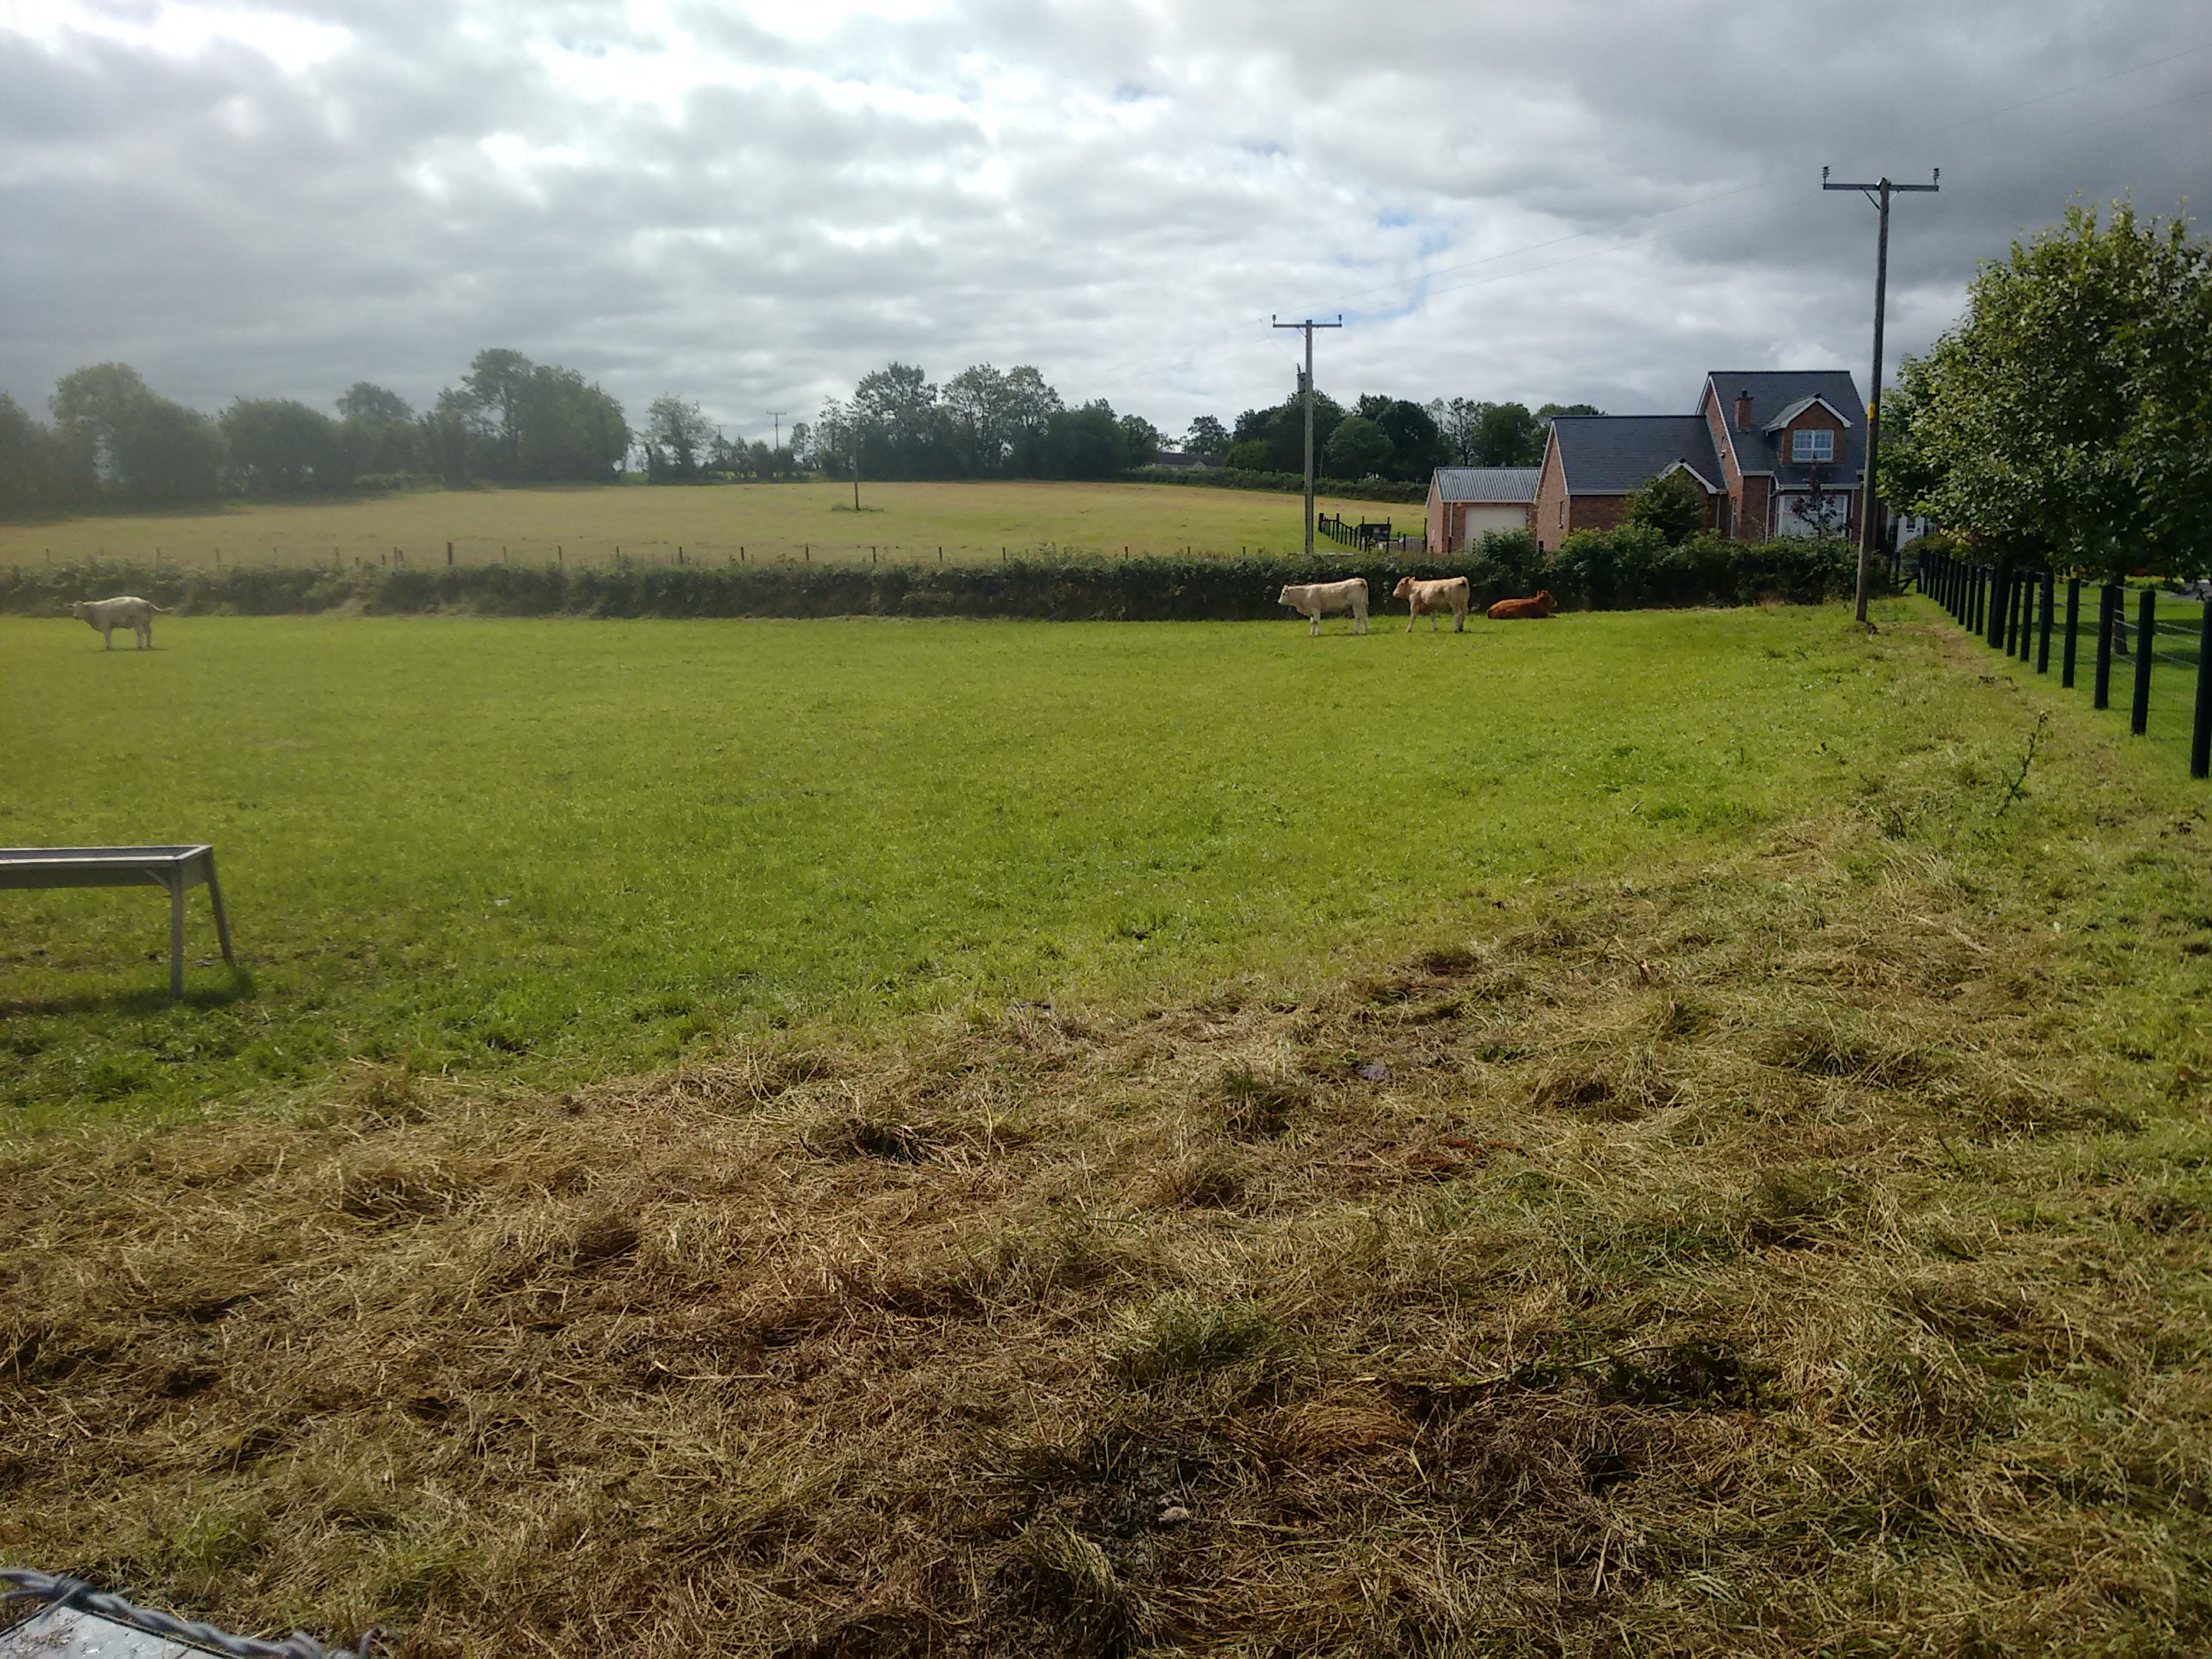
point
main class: Grassland
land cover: Grassland without tree/shrub cover
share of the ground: > 75 %
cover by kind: herbaceous plants 100 %
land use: Agriculture (excluding fallow land and kitchen gardens)
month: August
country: GB
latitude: 54.4499
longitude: -6.7418
